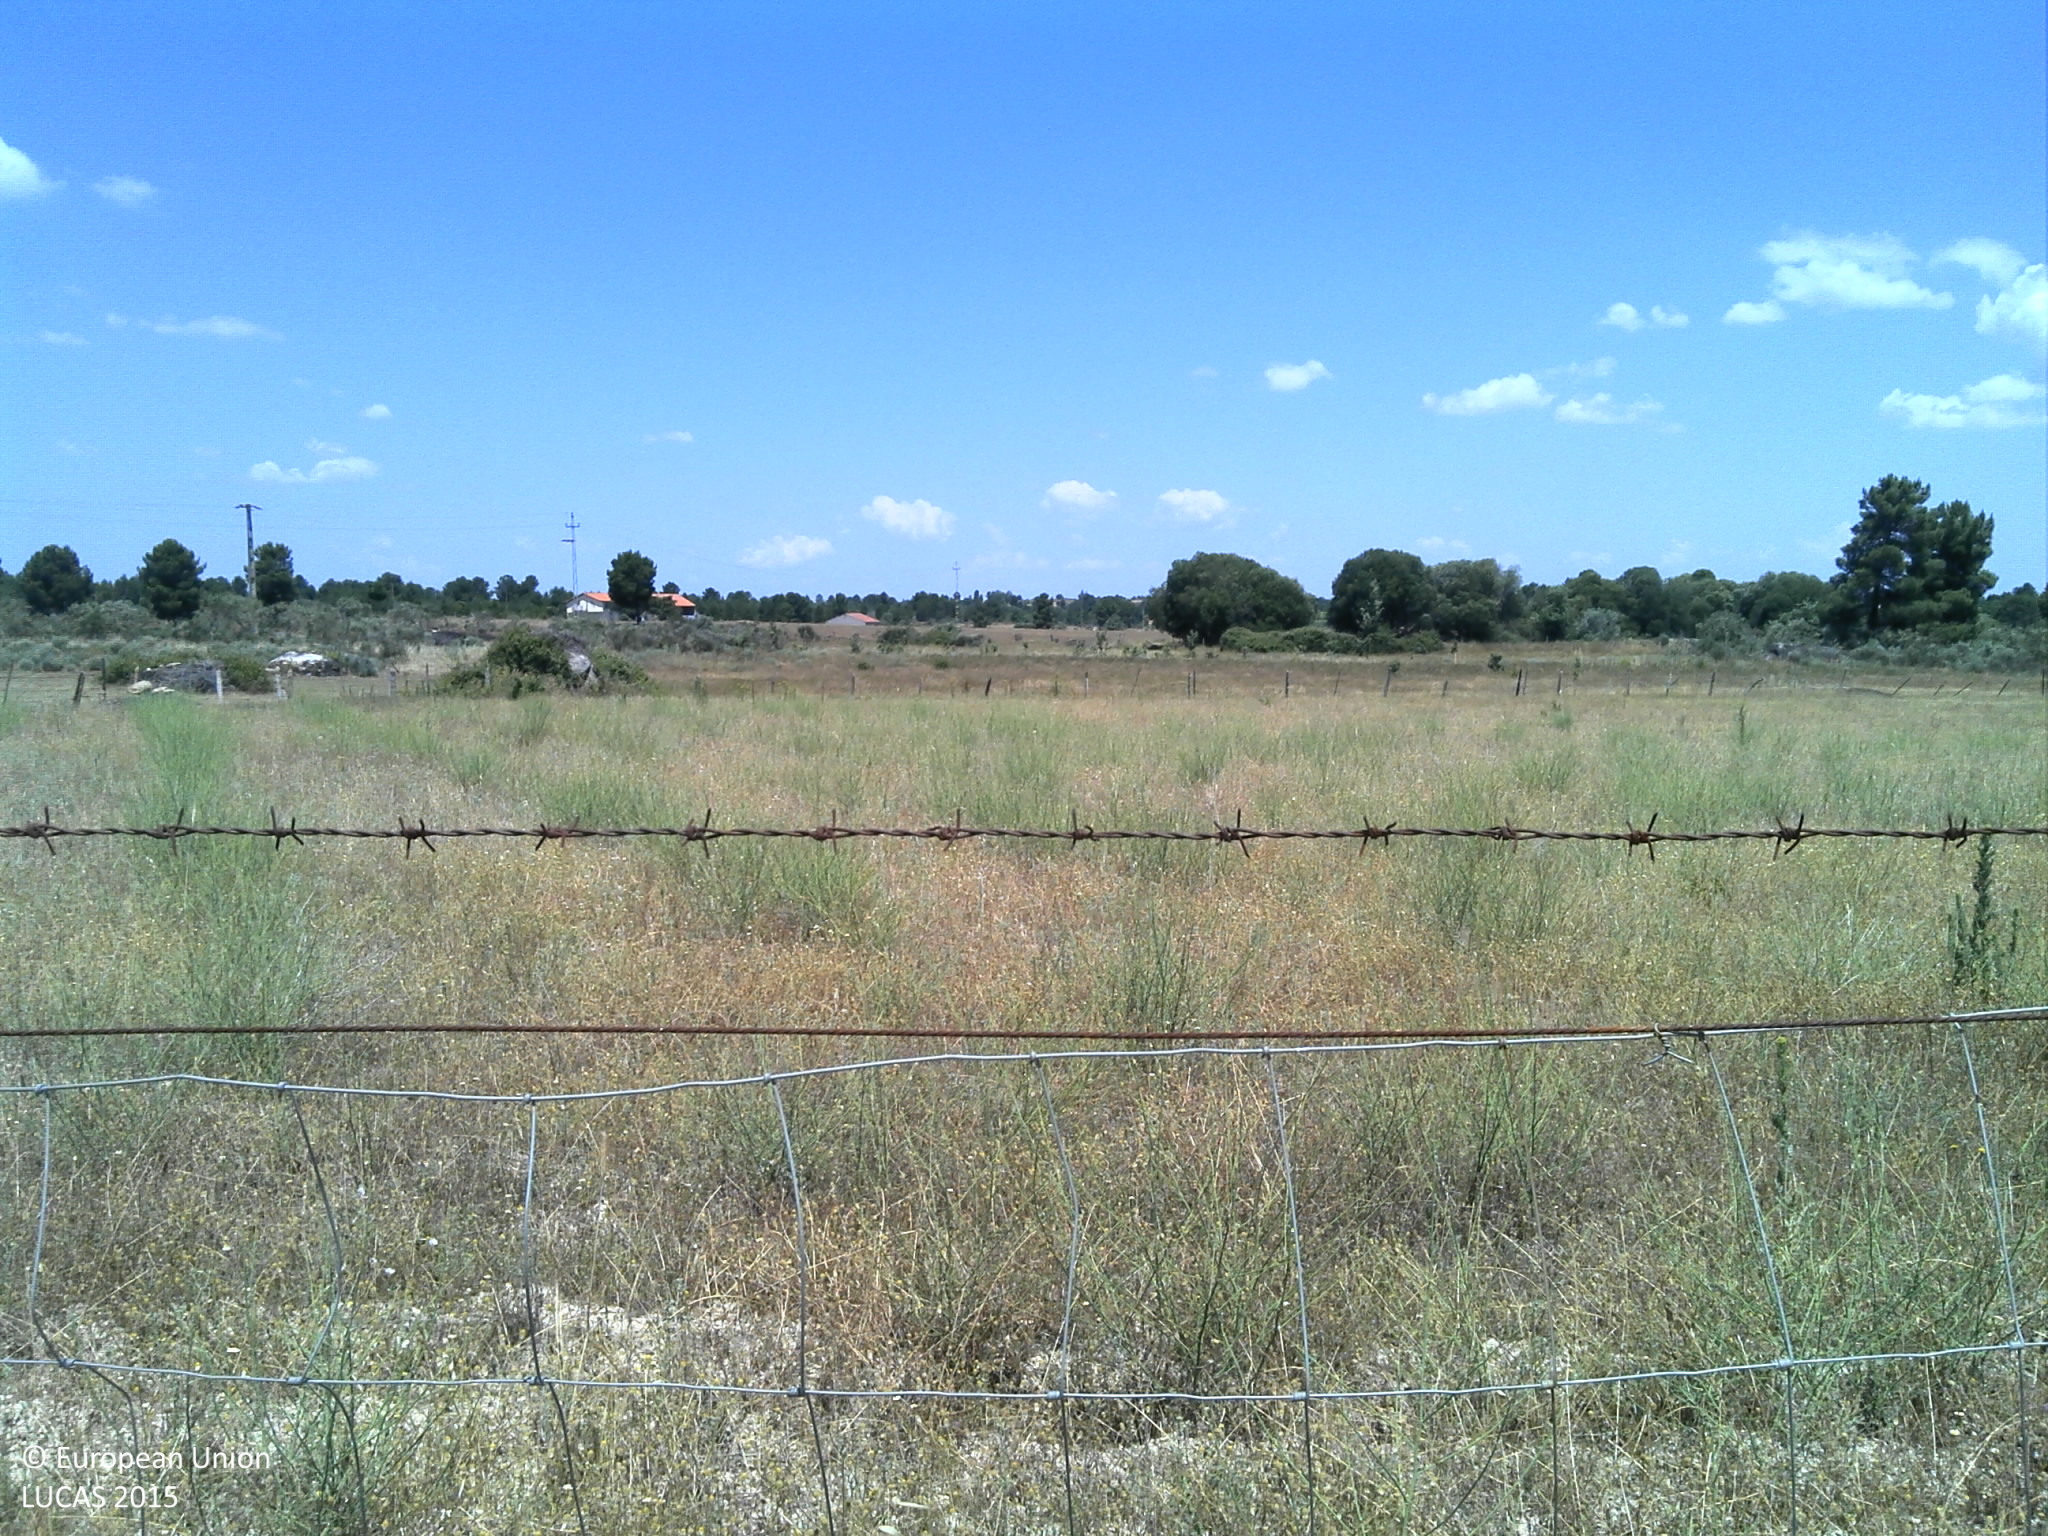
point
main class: Grassland
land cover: Grassland without tree/shrub cover
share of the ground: > 75 %
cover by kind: herbaceous plants 80 %, unconsolidated bare surface 20 %
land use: Agriculture (excluding fallow land and kitchen gardens)
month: June
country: PT
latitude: 40.7327
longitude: -7.1692
